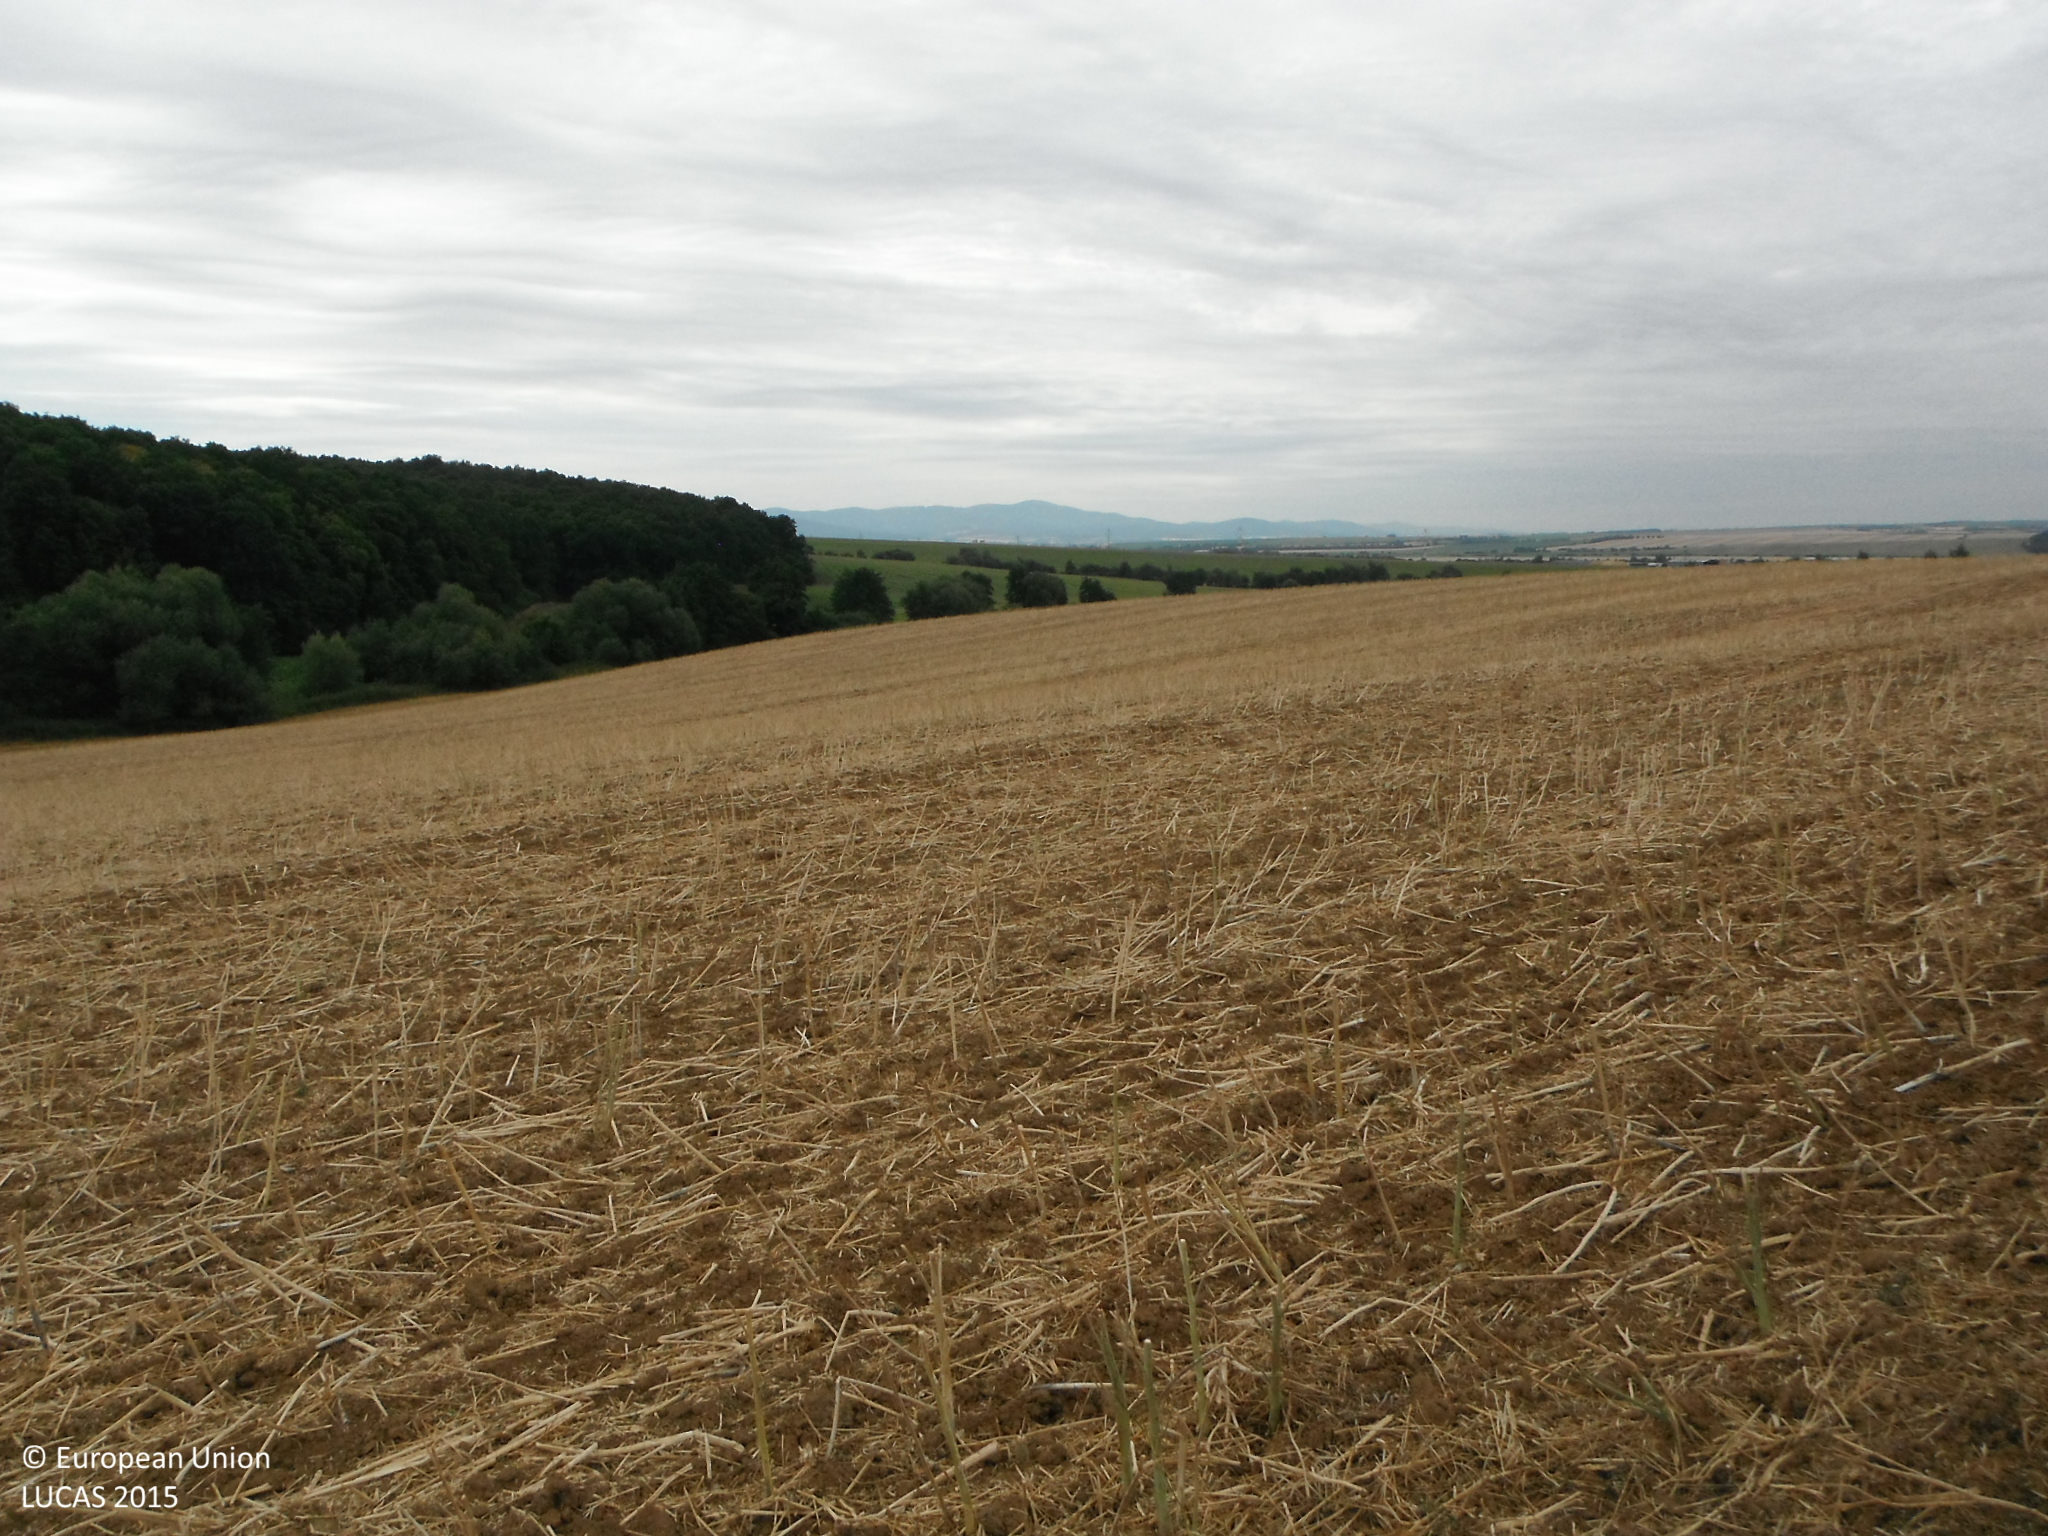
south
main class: Cropland
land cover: Rape and turnip rape
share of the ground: < 10 %
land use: Agriculture (excluding fallow land and kitchen gardens)
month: July
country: SK
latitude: 48.7086
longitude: 18.2645
